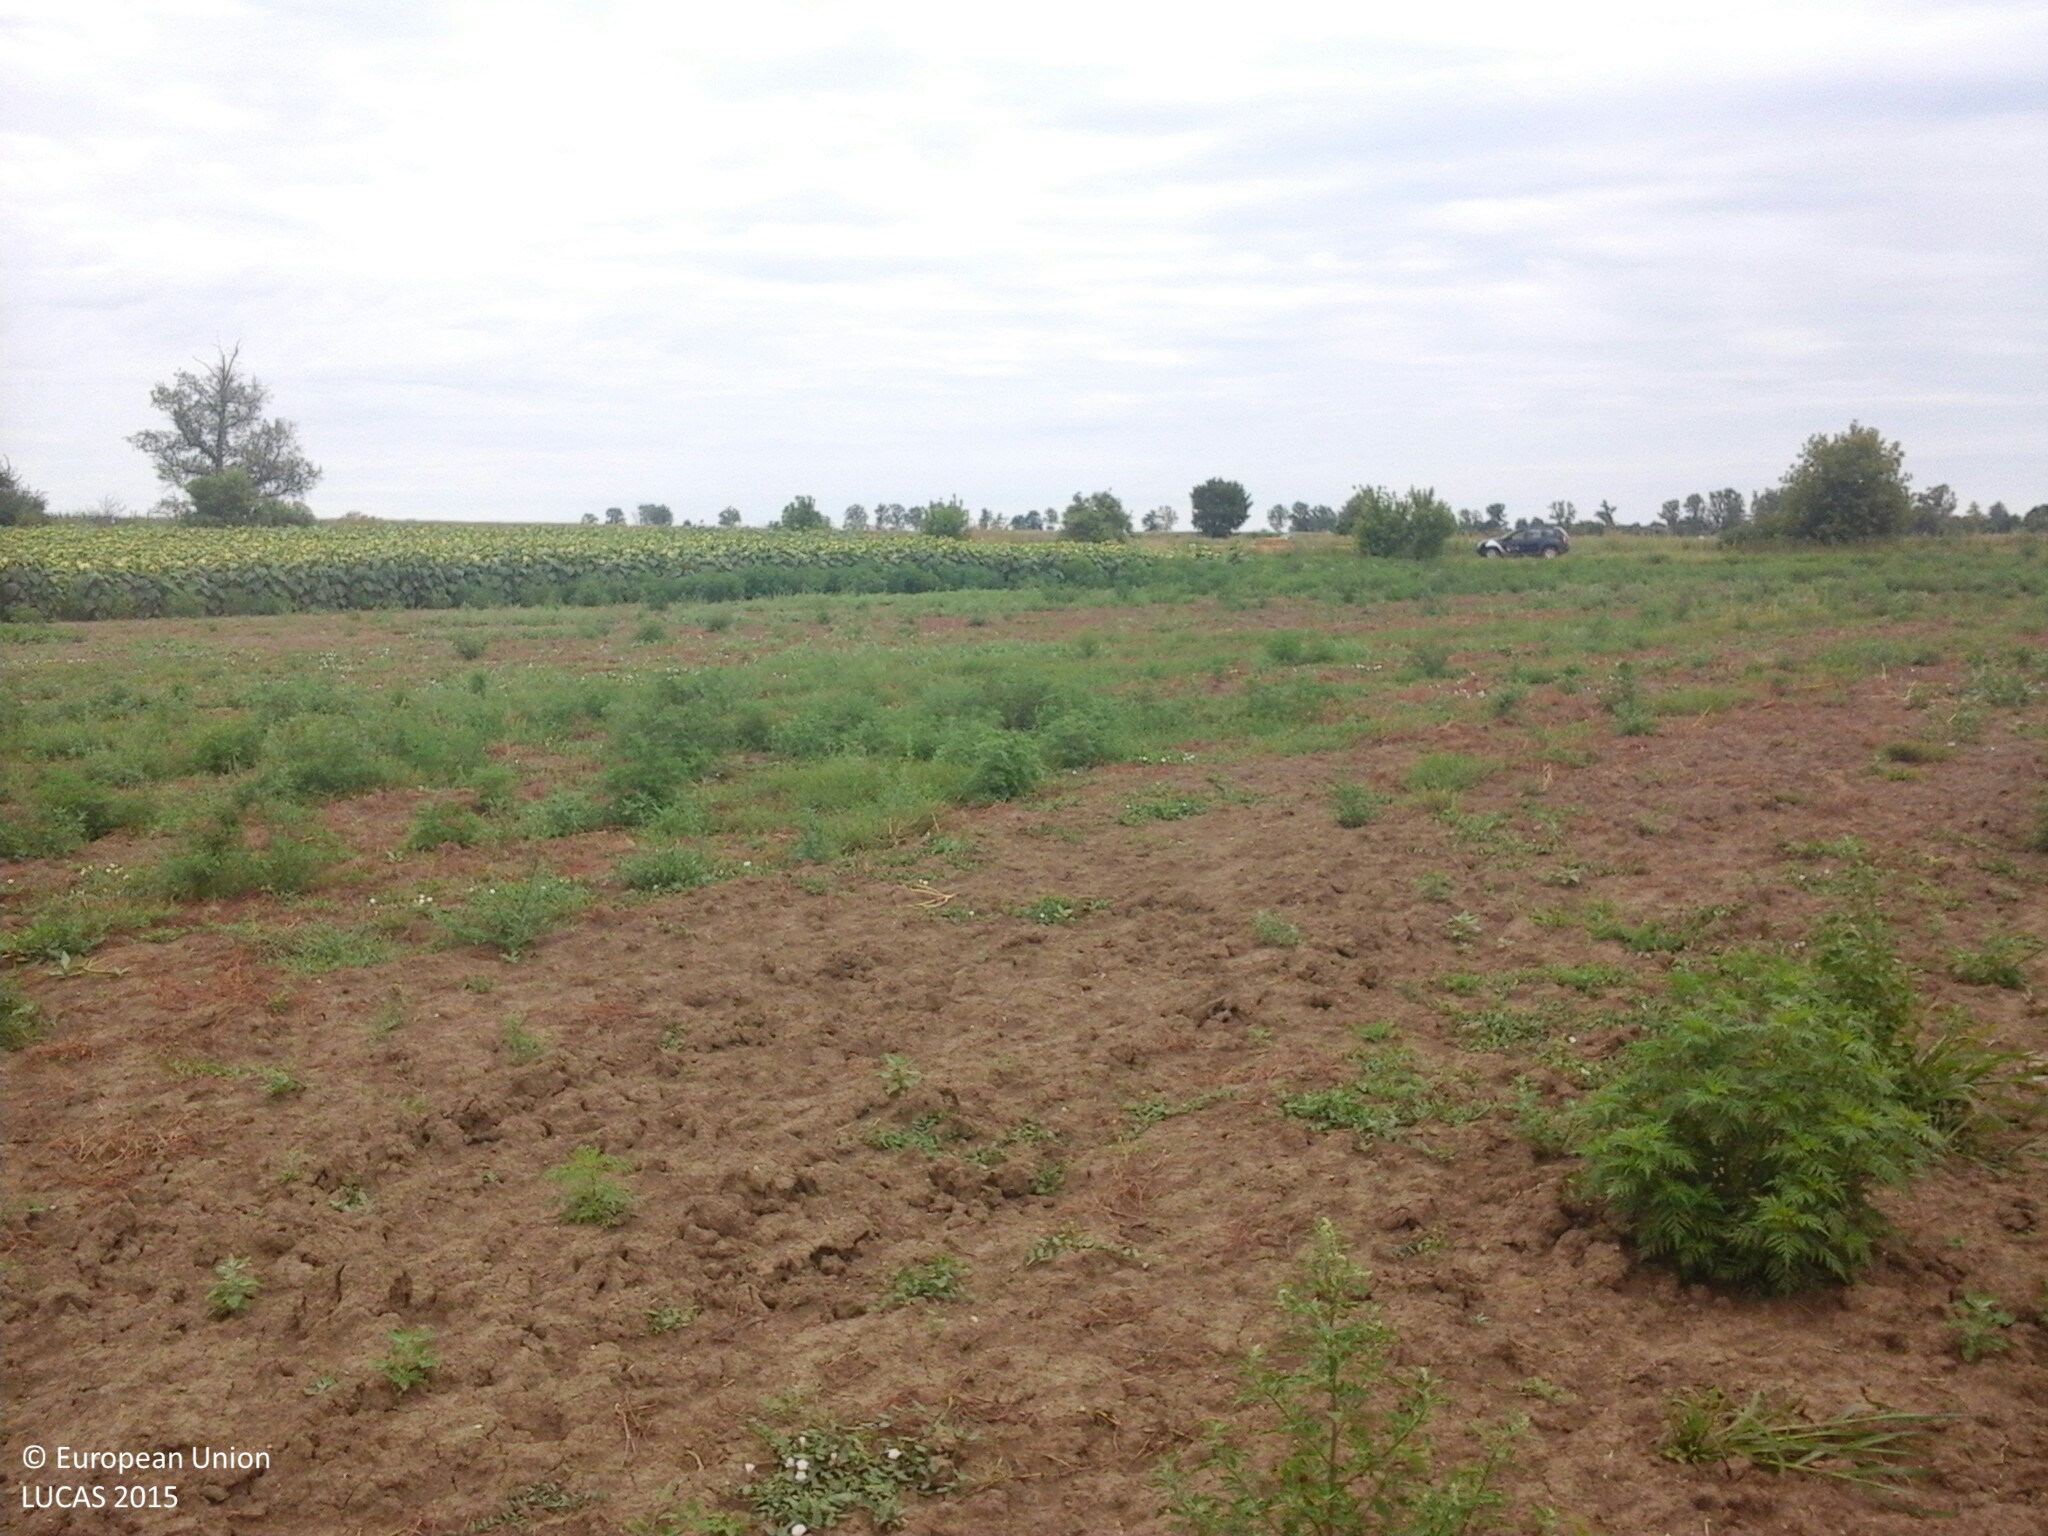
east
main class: Cropland
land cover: Sunflower
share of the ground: > 75 %
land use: Agriculture (excluding fallow land and kitchen gardens)
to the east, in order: Sunflower
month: July
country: HU
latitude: 47.0585
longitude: 18.0802
